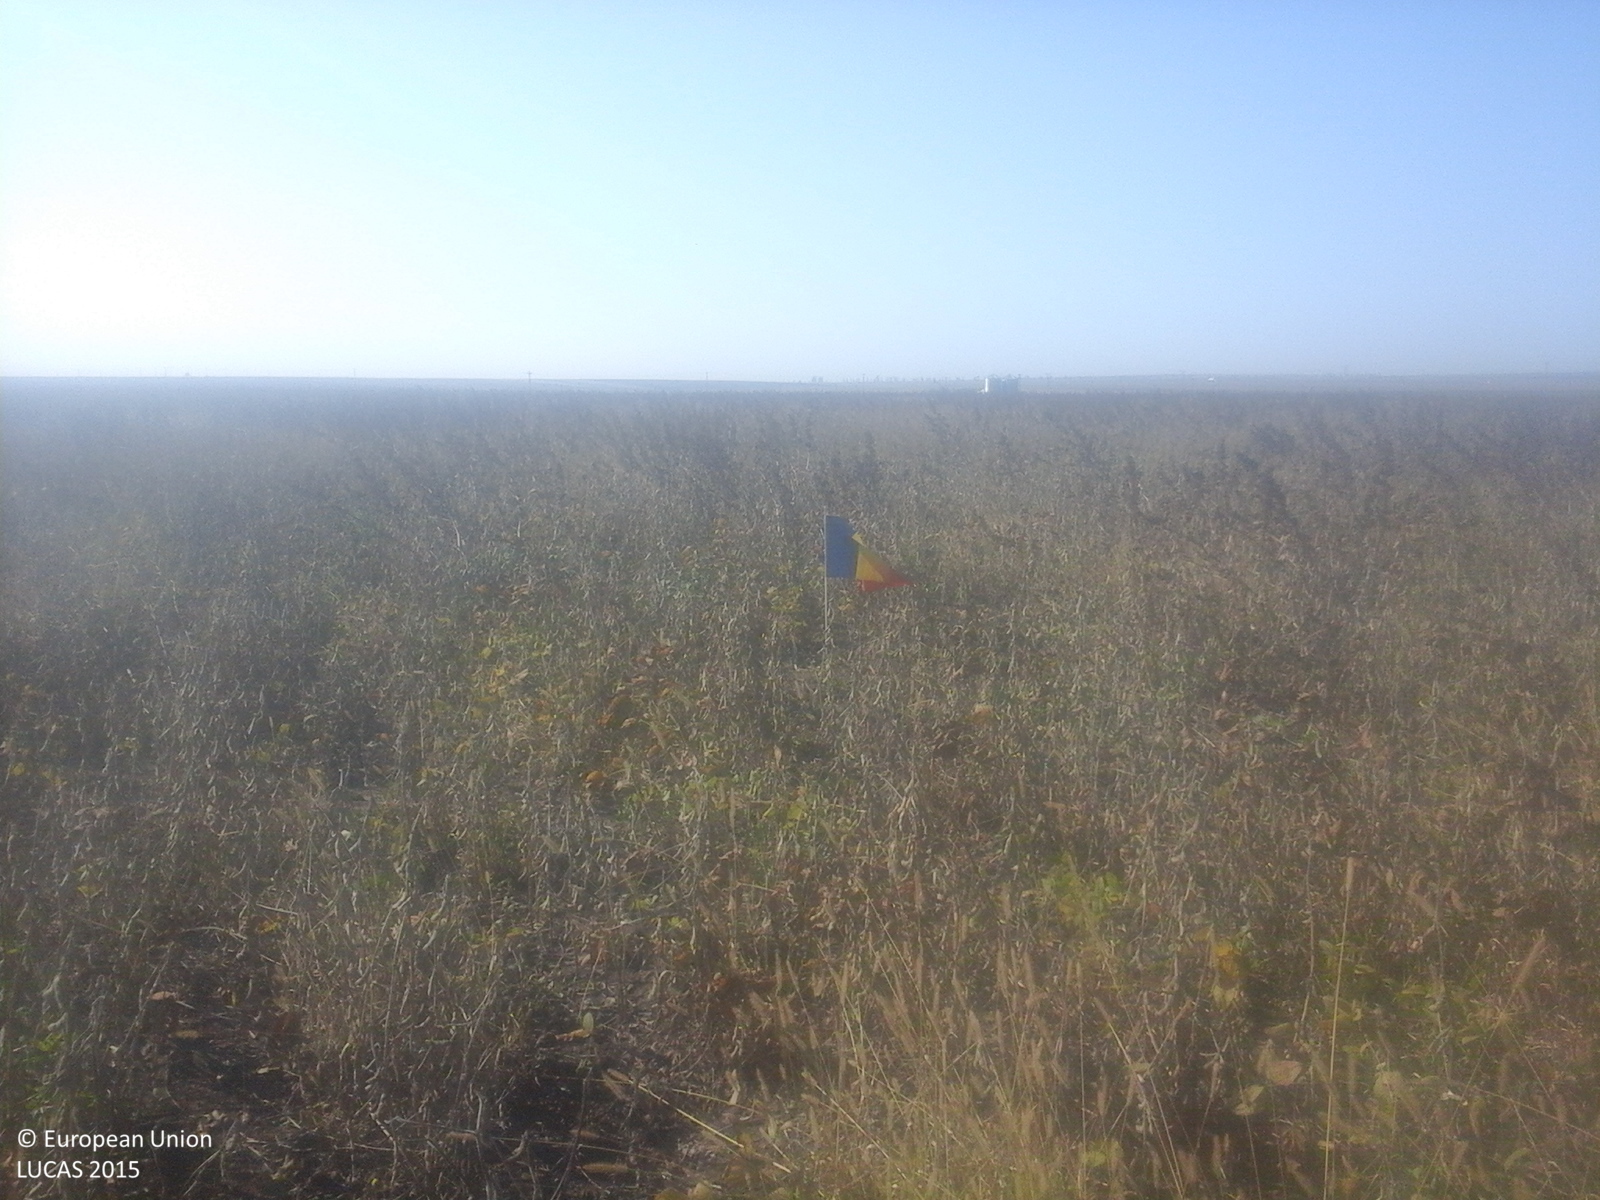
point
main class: Cropland
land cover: Soya
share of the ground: > 75 %
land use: Agriculture (excluding fallow land and kitchen gardens)
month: October
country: RO
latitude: 45.3283
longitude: 26.9917
